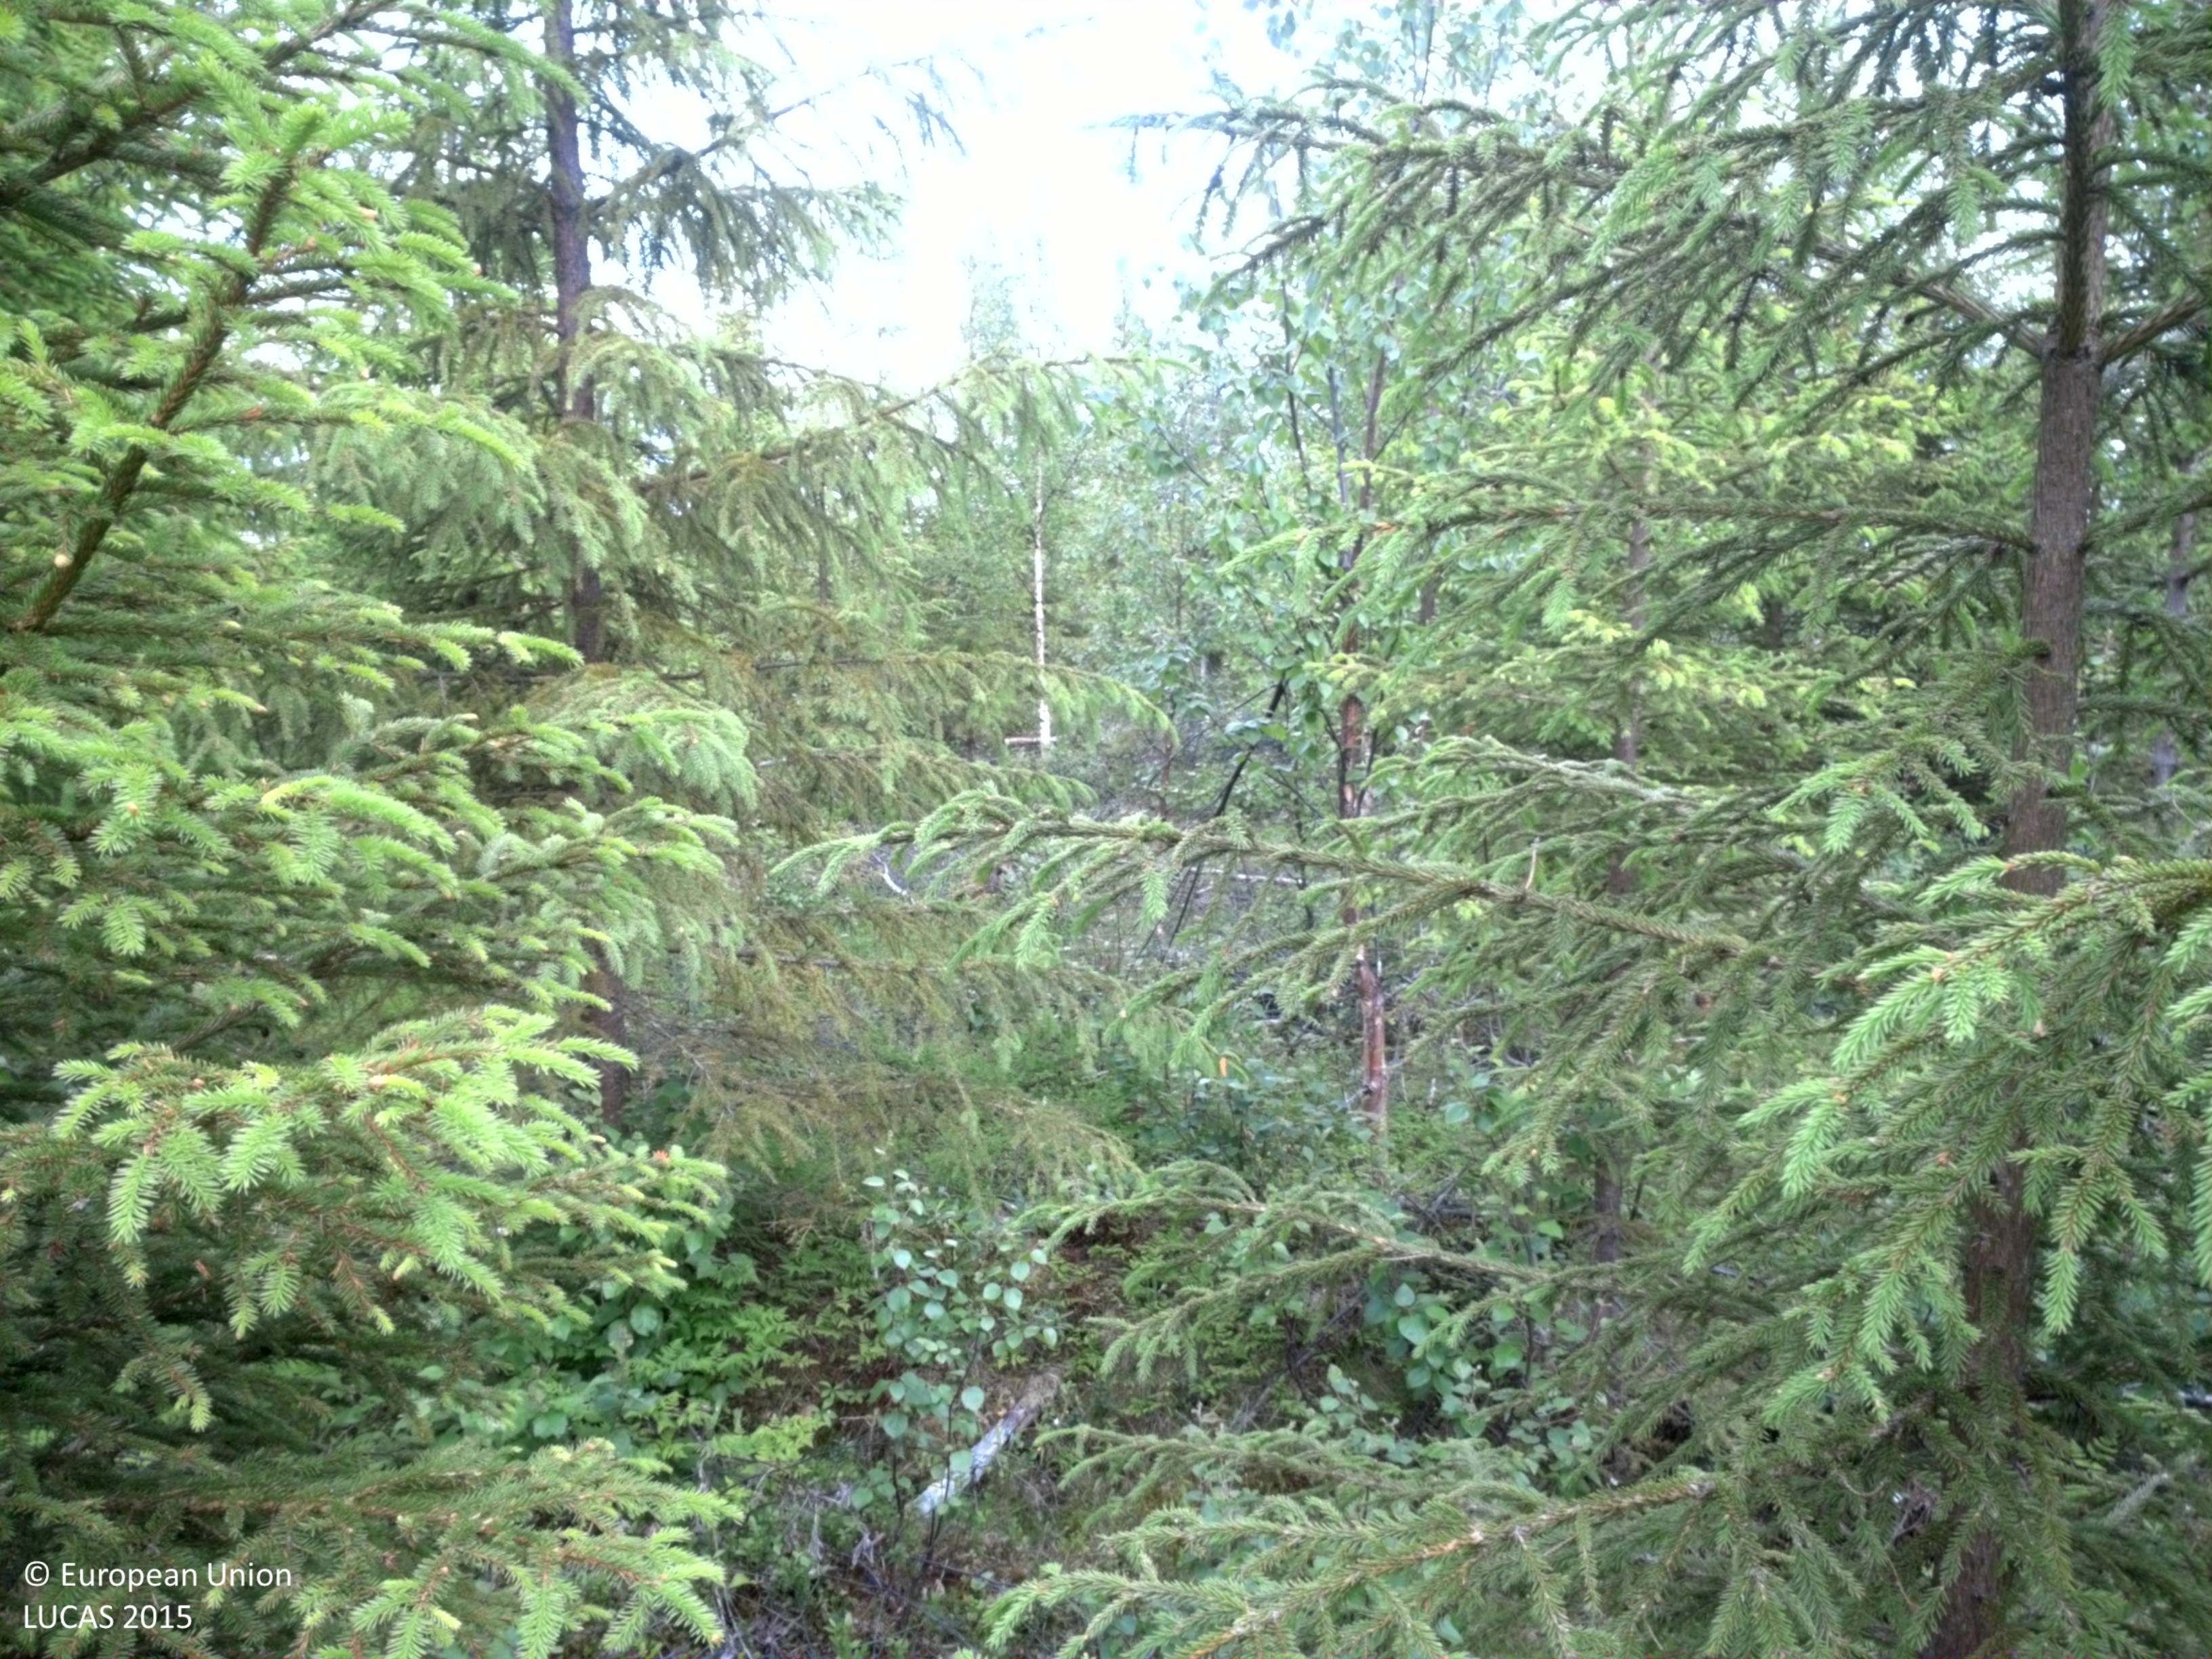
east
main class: Woodland
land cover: Spruce dominated mixed woodland
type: boreal forest
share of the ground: 50 - 75 %
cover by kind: coniferous forest trees 45 %, herbaceous plants 20 %, broadleaved forest trees 15 %, shrubs 15 %, lichens and mosses 5 %
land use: Forestry
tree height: > 5 m
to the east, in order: Spruce dominated mixed woodland; Other mixed woodland; Spruce dominated mixed woodland; Ditches and canals; Broadleaved woodland
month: July
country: SE
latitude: 64.5375
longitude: 18.0768
